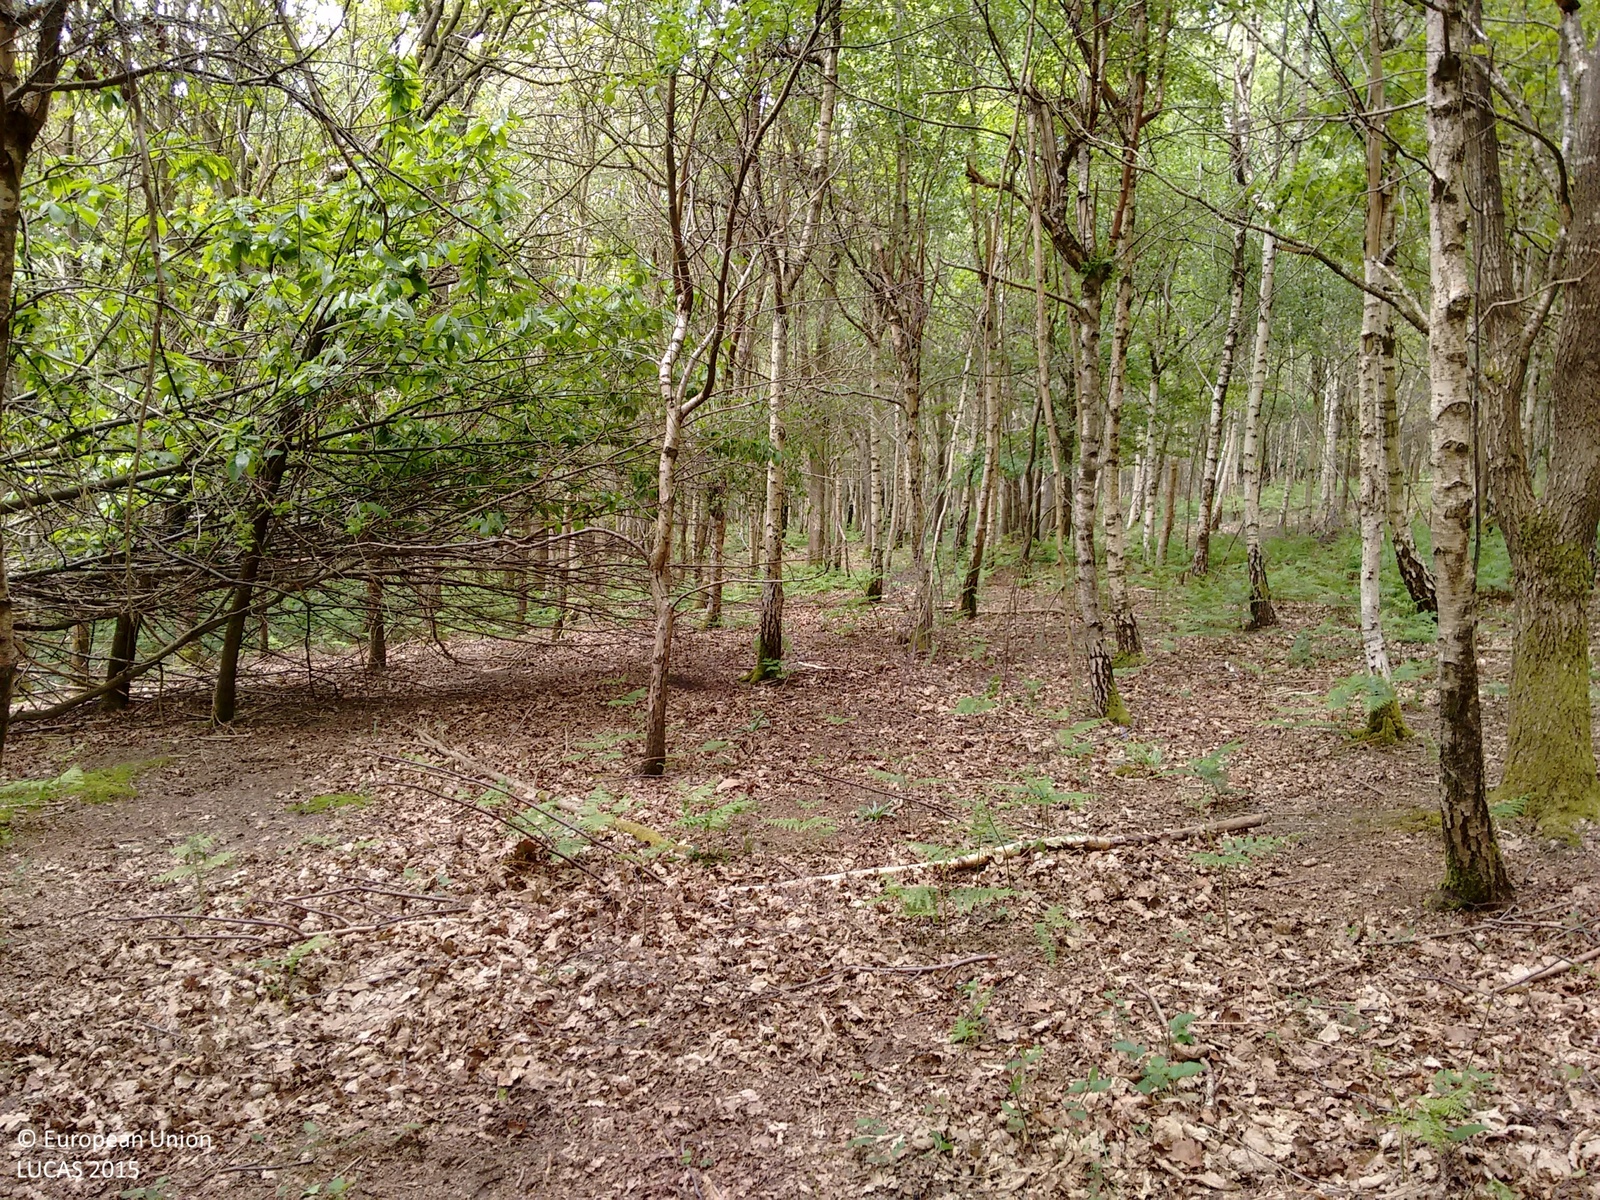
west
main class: Woodland
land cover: Broadleaved woodland
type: mesophytic deciduous forest
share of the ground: > 75 %
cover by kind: broadleaved forest trees 95 %, coniferous forest trees 5 %
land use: Forestry
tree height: > 5 m
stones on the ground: < 10 %
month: May
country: GB
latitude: 51.1125
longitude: 0.3286
